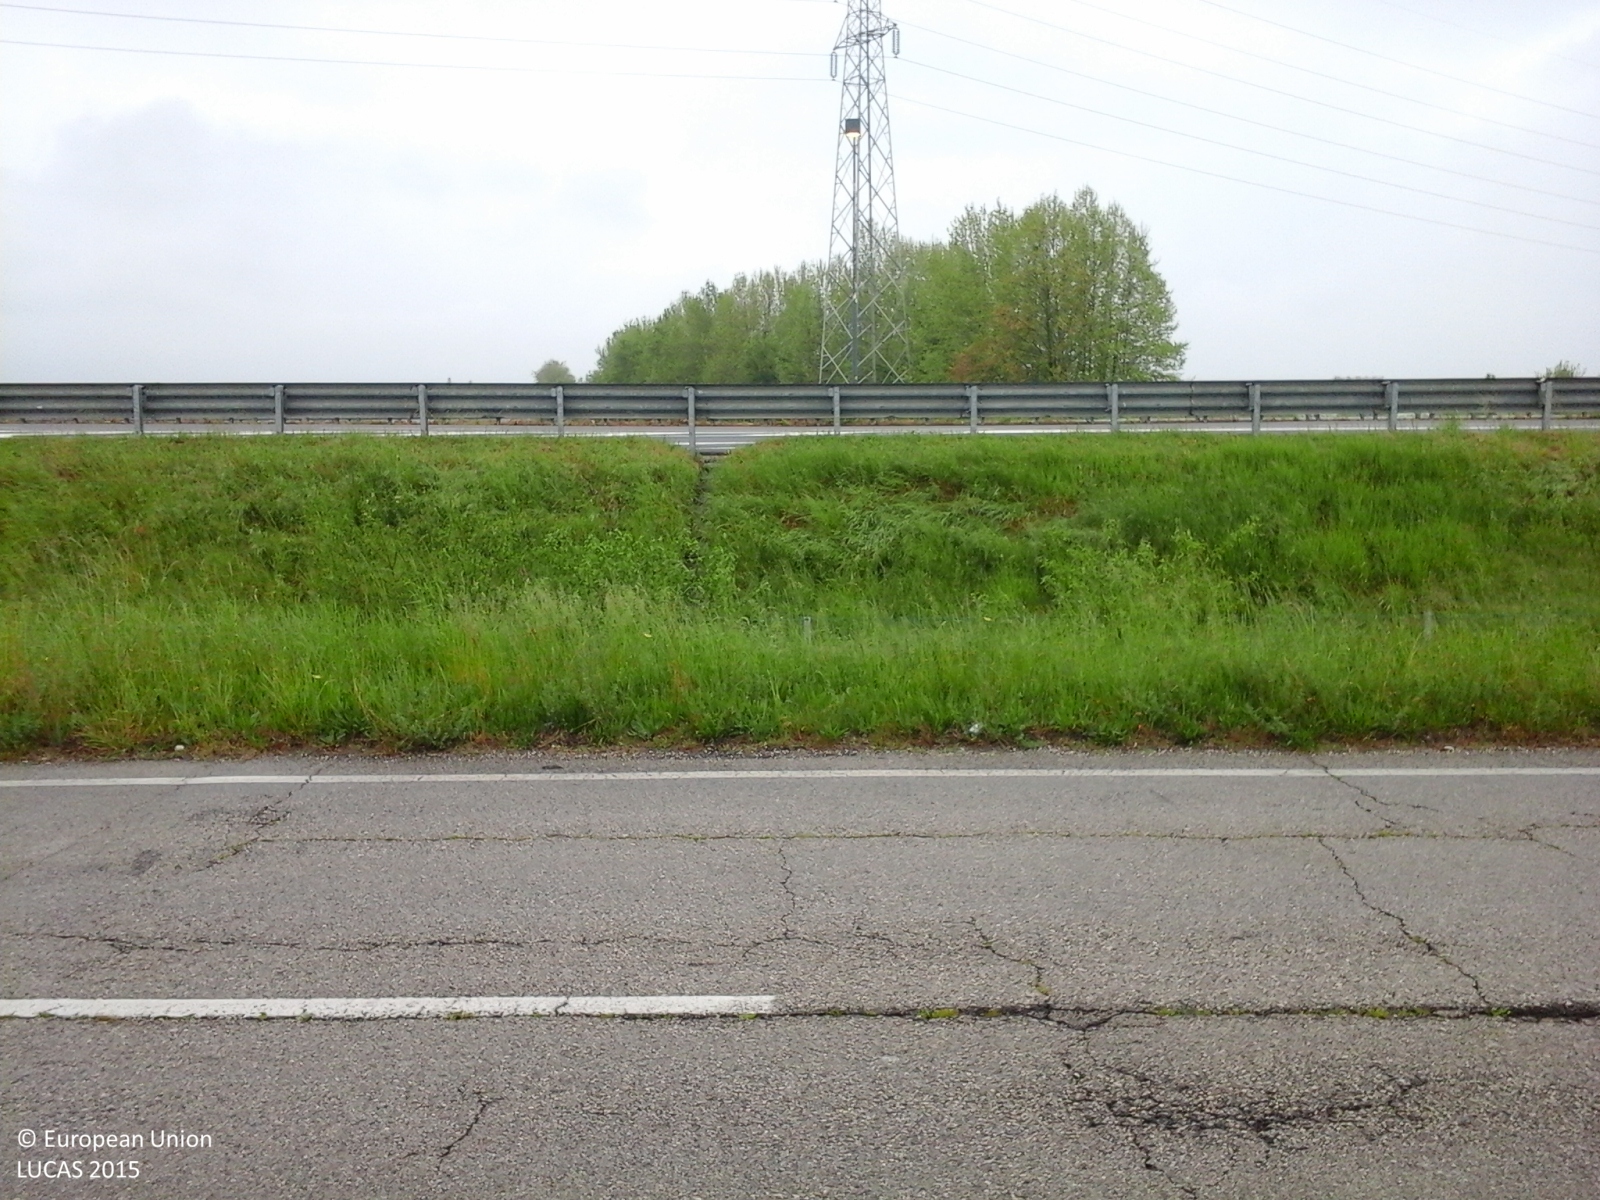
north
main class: Cropland
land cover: Common wheat
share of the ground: > 75 %
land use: Agriculture (excluding fallow land and kitchen gardens)
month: April
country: IT
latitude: 45.5337
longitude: 12.2886
